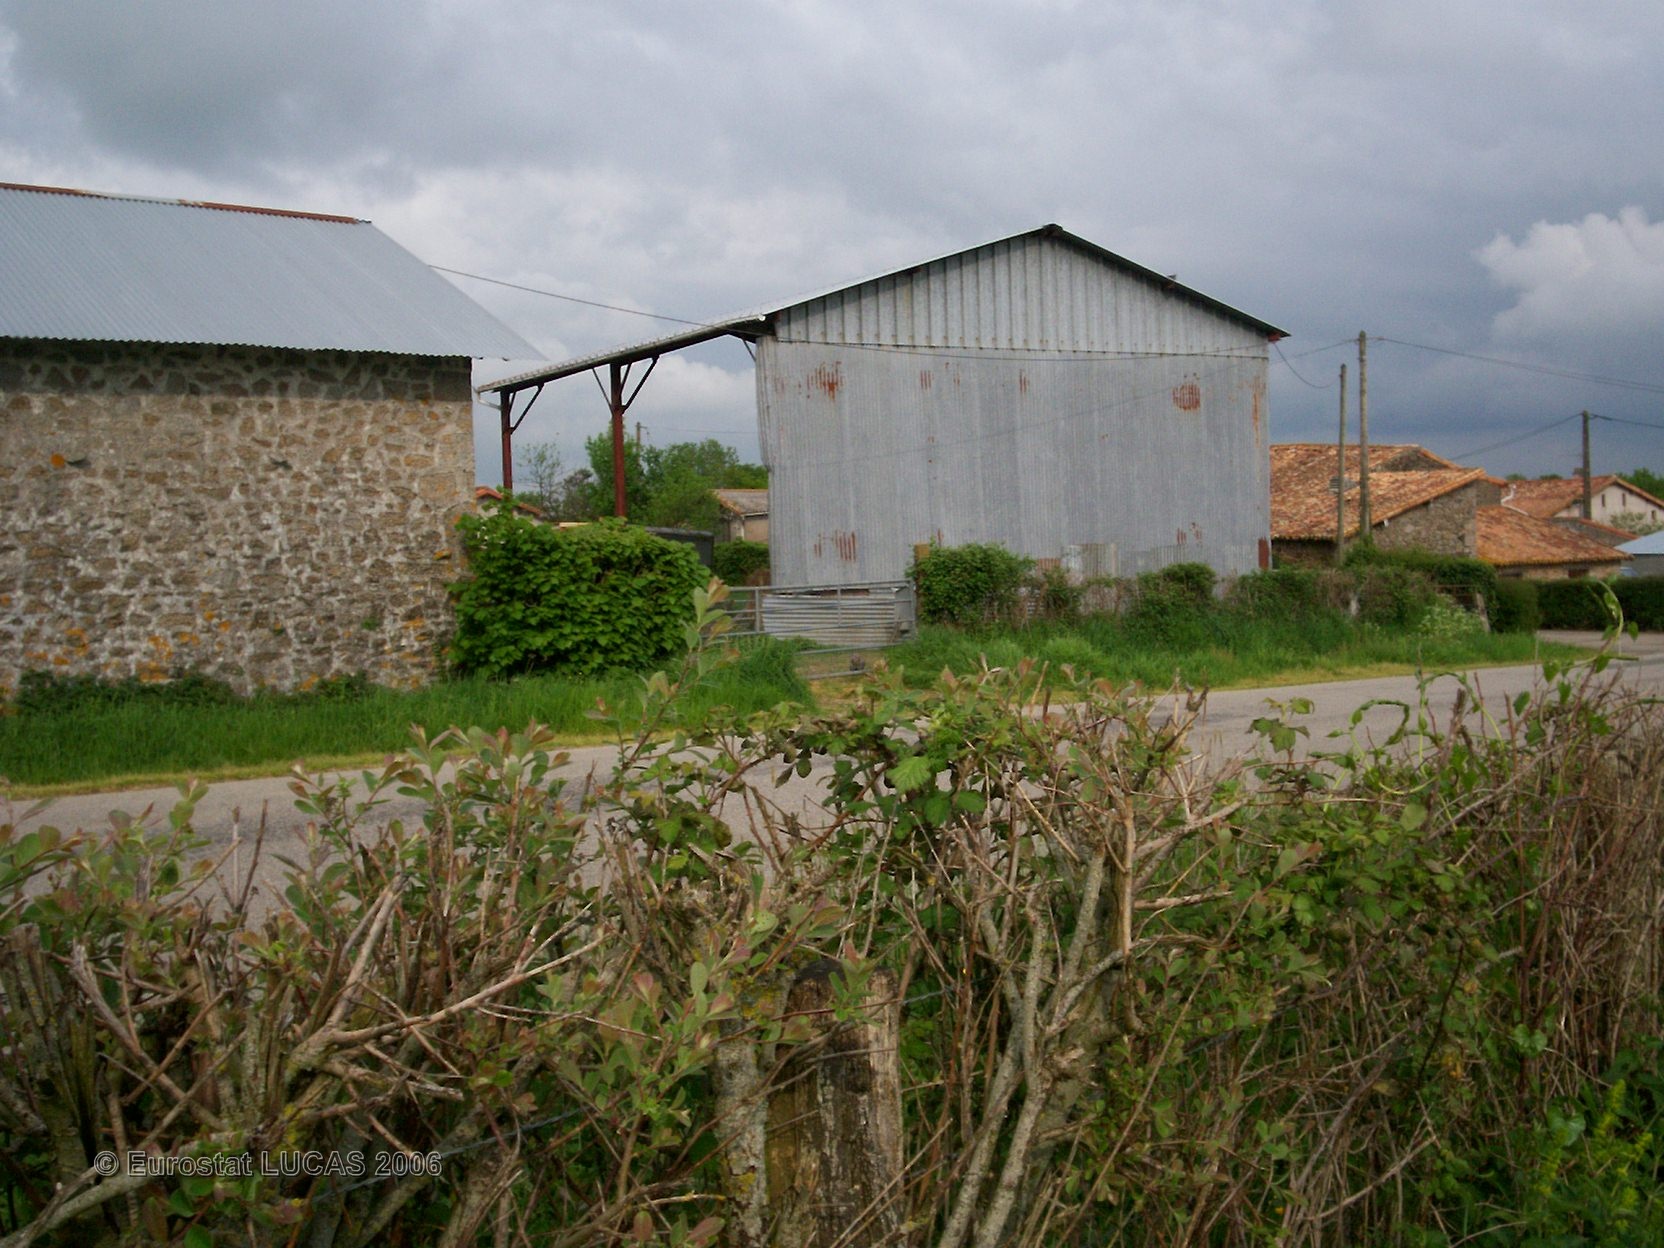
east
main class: Grassland
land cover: Grassland without tree/shrub cover
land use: Agriculture (excluding fallow land and kitchen gardens)
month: April
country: FR
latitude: 46.6835
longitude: -0.3414
